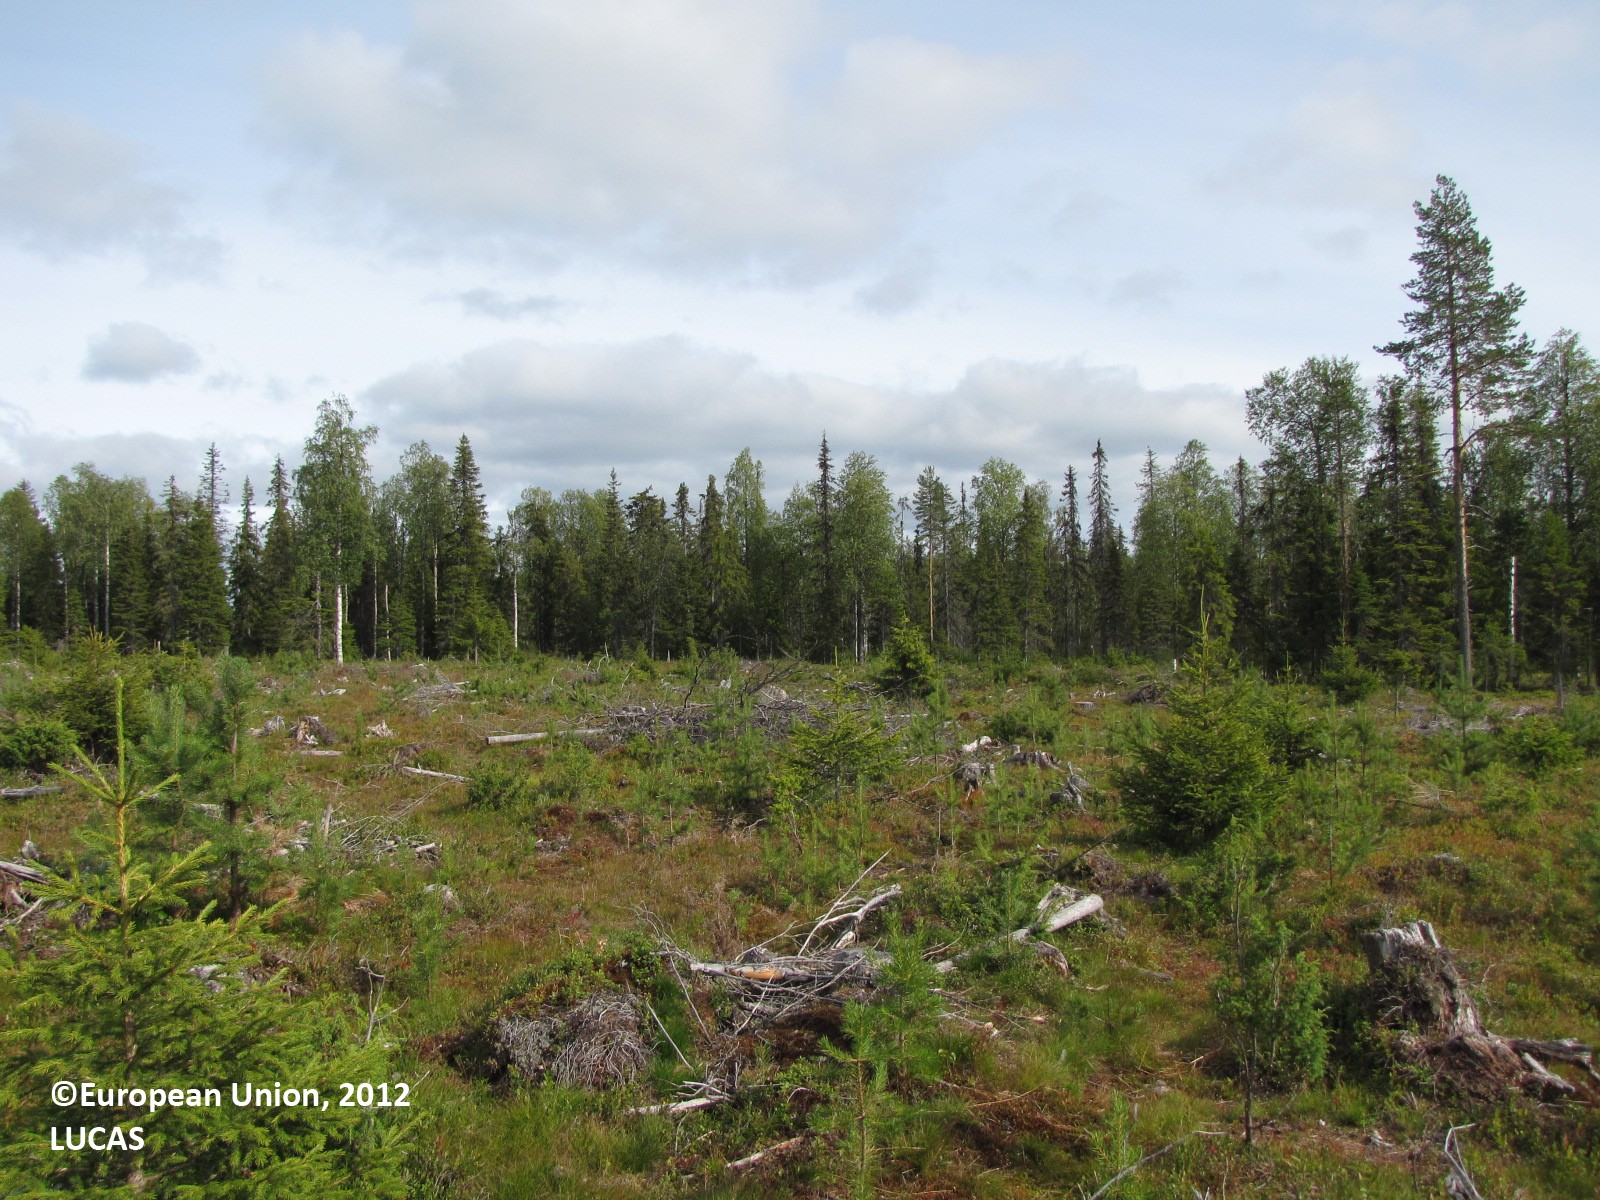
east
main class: Woodland
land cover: Pine dominated mixed woodland
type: boreal forest
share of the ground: 10 - 25 %
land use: Forestry
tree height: < 5 m
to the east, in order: Pine dominated mixed woodland; Spruce dominated mixed woodland; Pine dominated coniferous woodland; Inland marshes
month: August
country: FI
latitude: 66.9266
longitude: 24.6526
